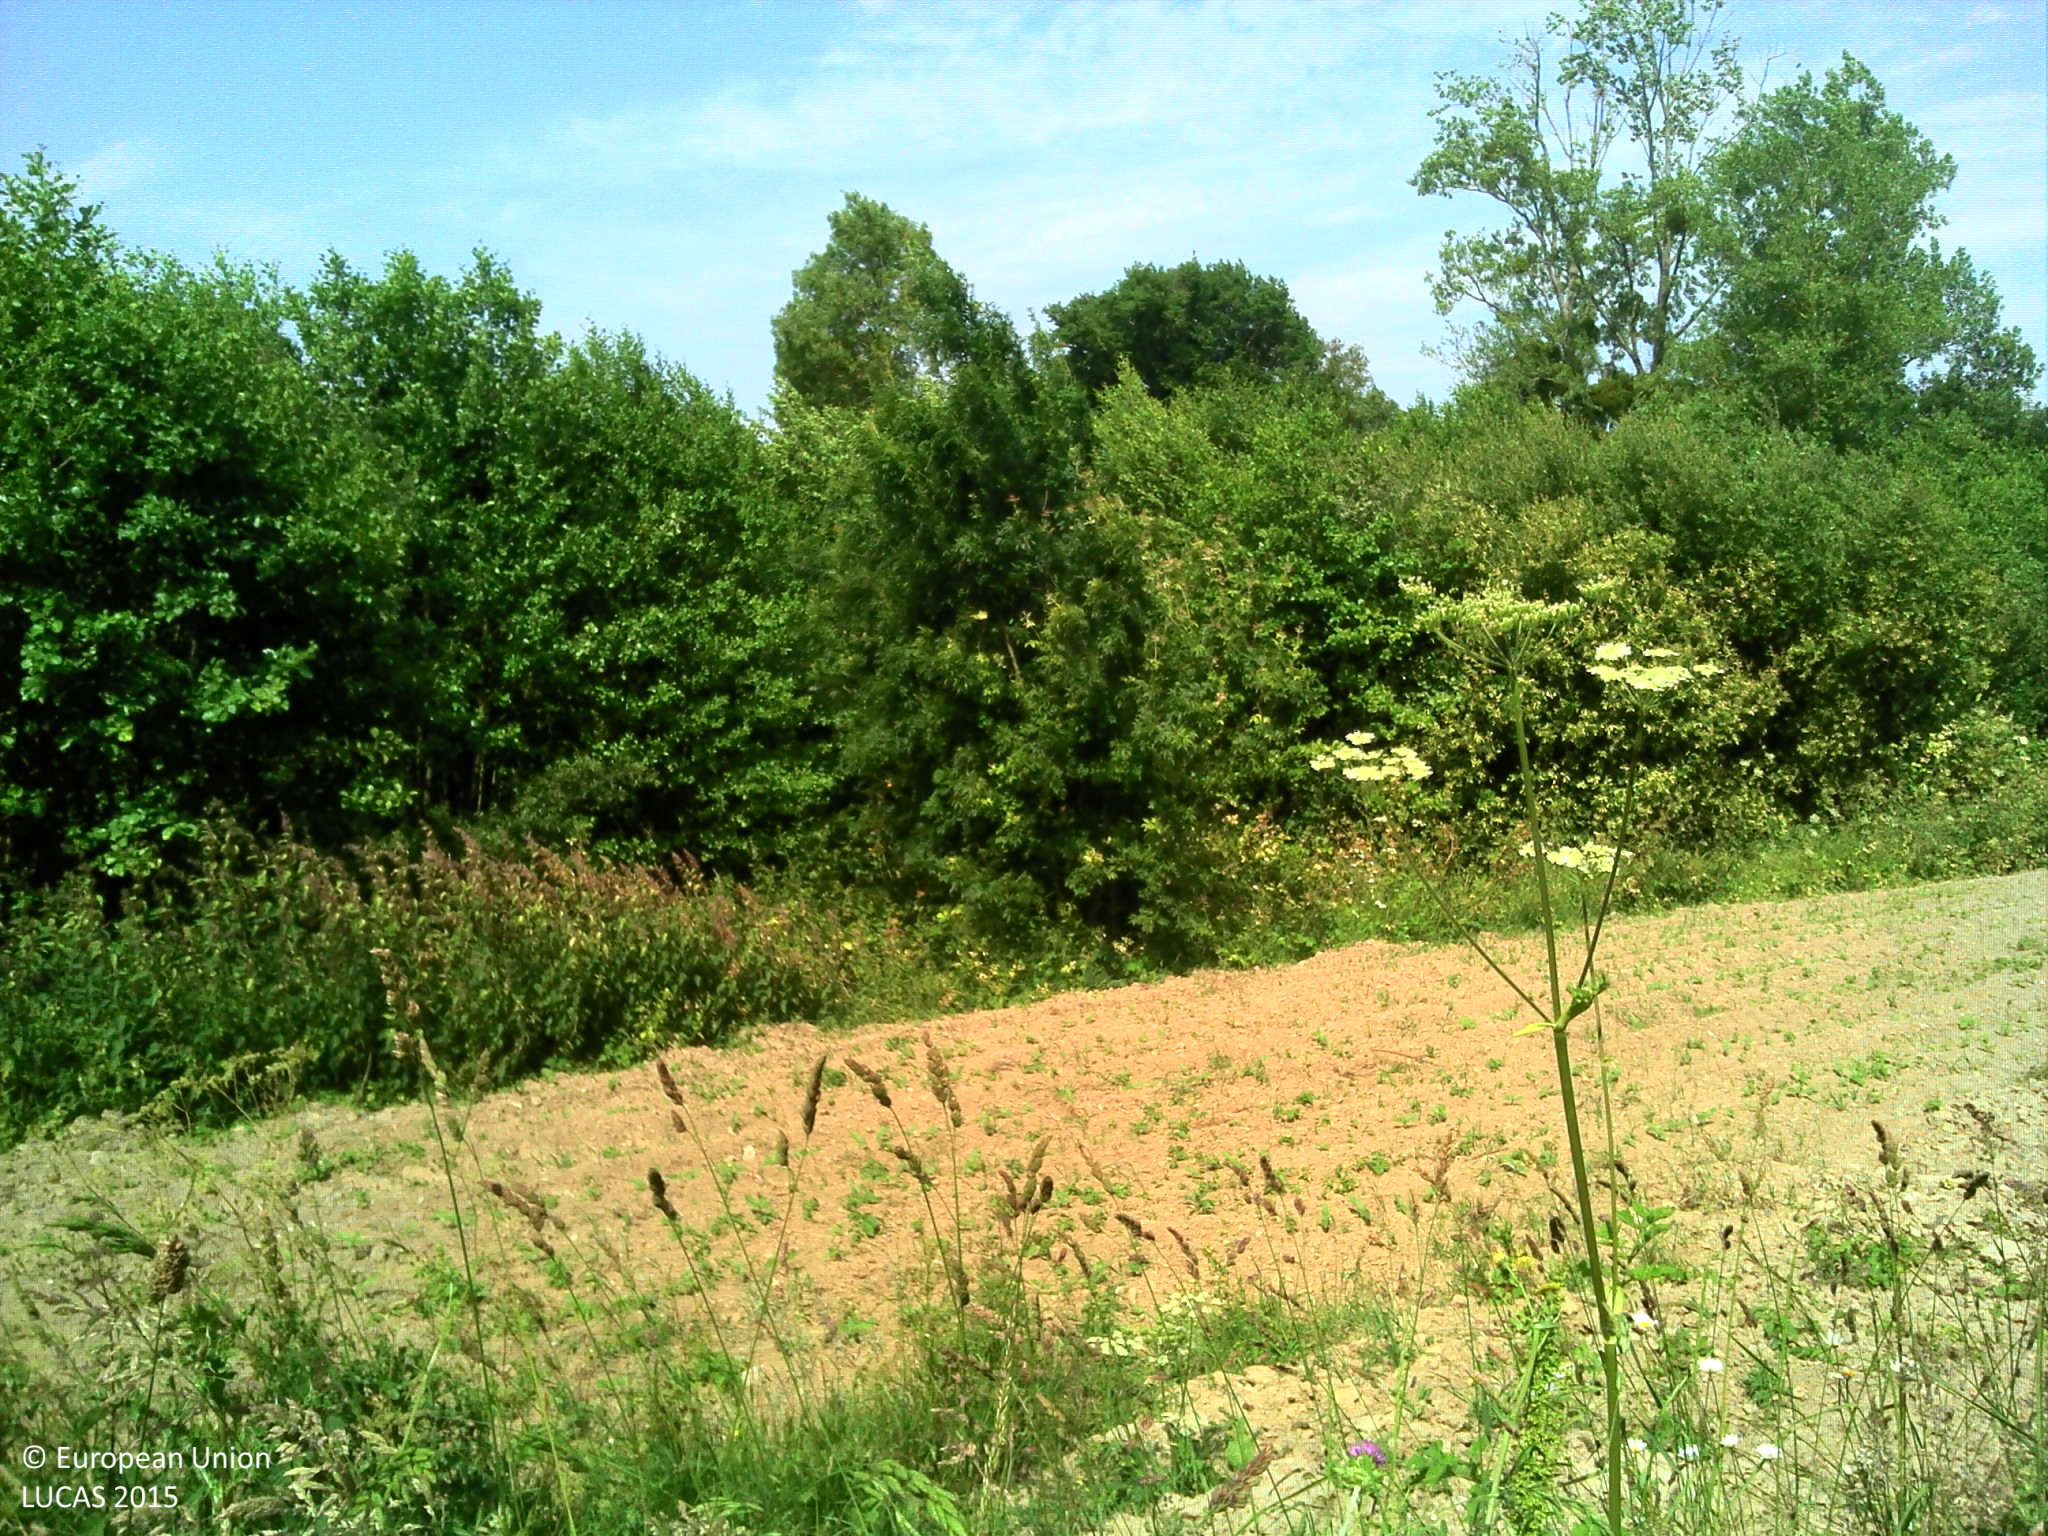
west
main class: Grassland
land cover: Spontaneously vegetated surfaces
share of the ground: > 75 %
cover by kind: herbaceous plants 100 %
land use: Agriculture (excluding fallow land and kitchen gardens)
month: June
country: FR
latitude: 46.8702
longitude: -1.7055
